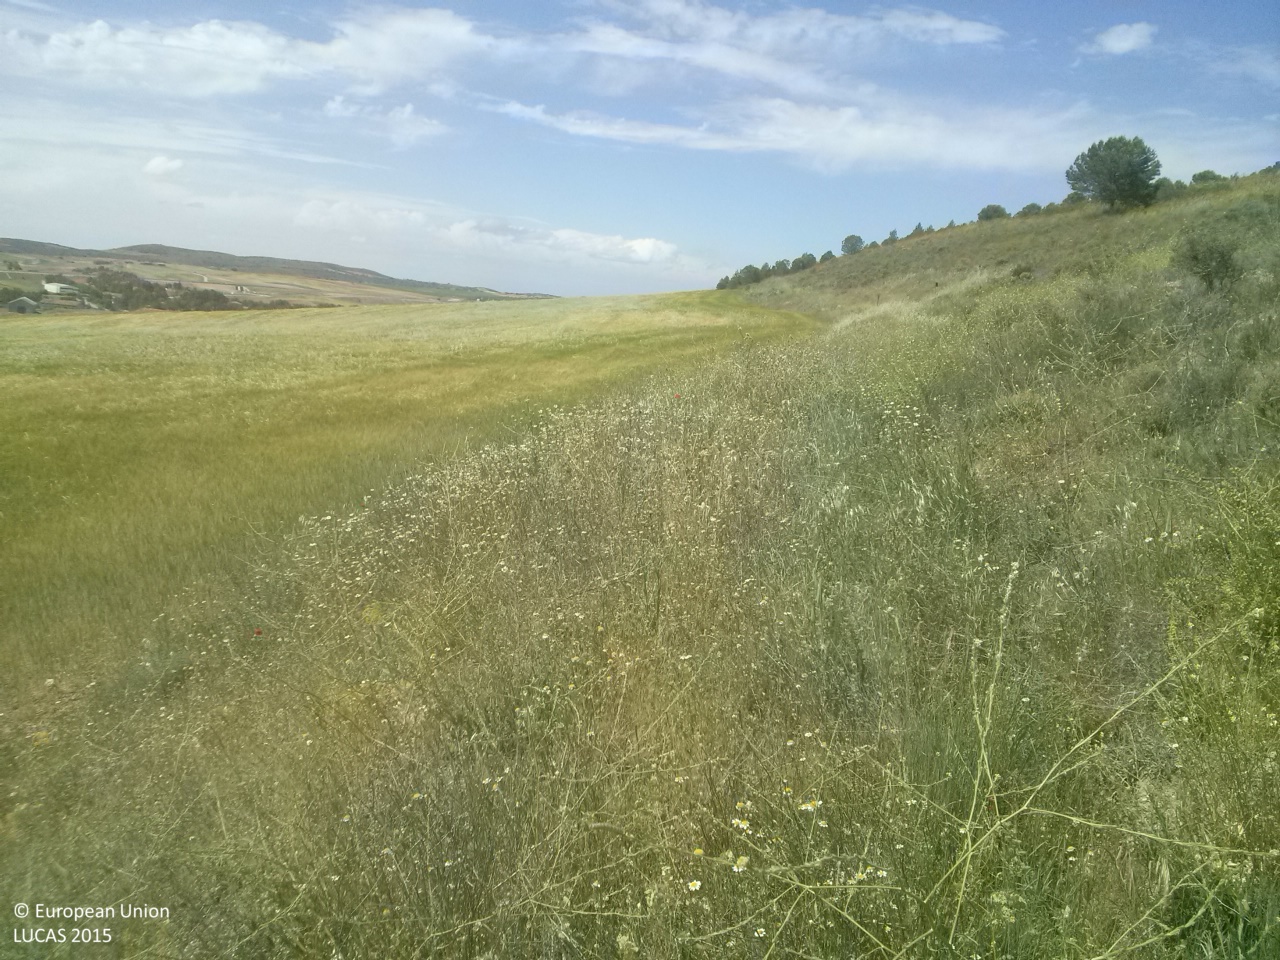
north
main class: Shrubland
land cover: Shrubland with sparse tree cover
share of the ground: 50 - 75 %
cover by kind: shrubs 55 %, herbaceous plants 20 %, unconsolidated bare surface 20 %, coniferous forest trees 5 %
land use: Forestry
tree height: > 5 m
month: May
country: ES
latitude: 40.0367
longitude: -2.8791
